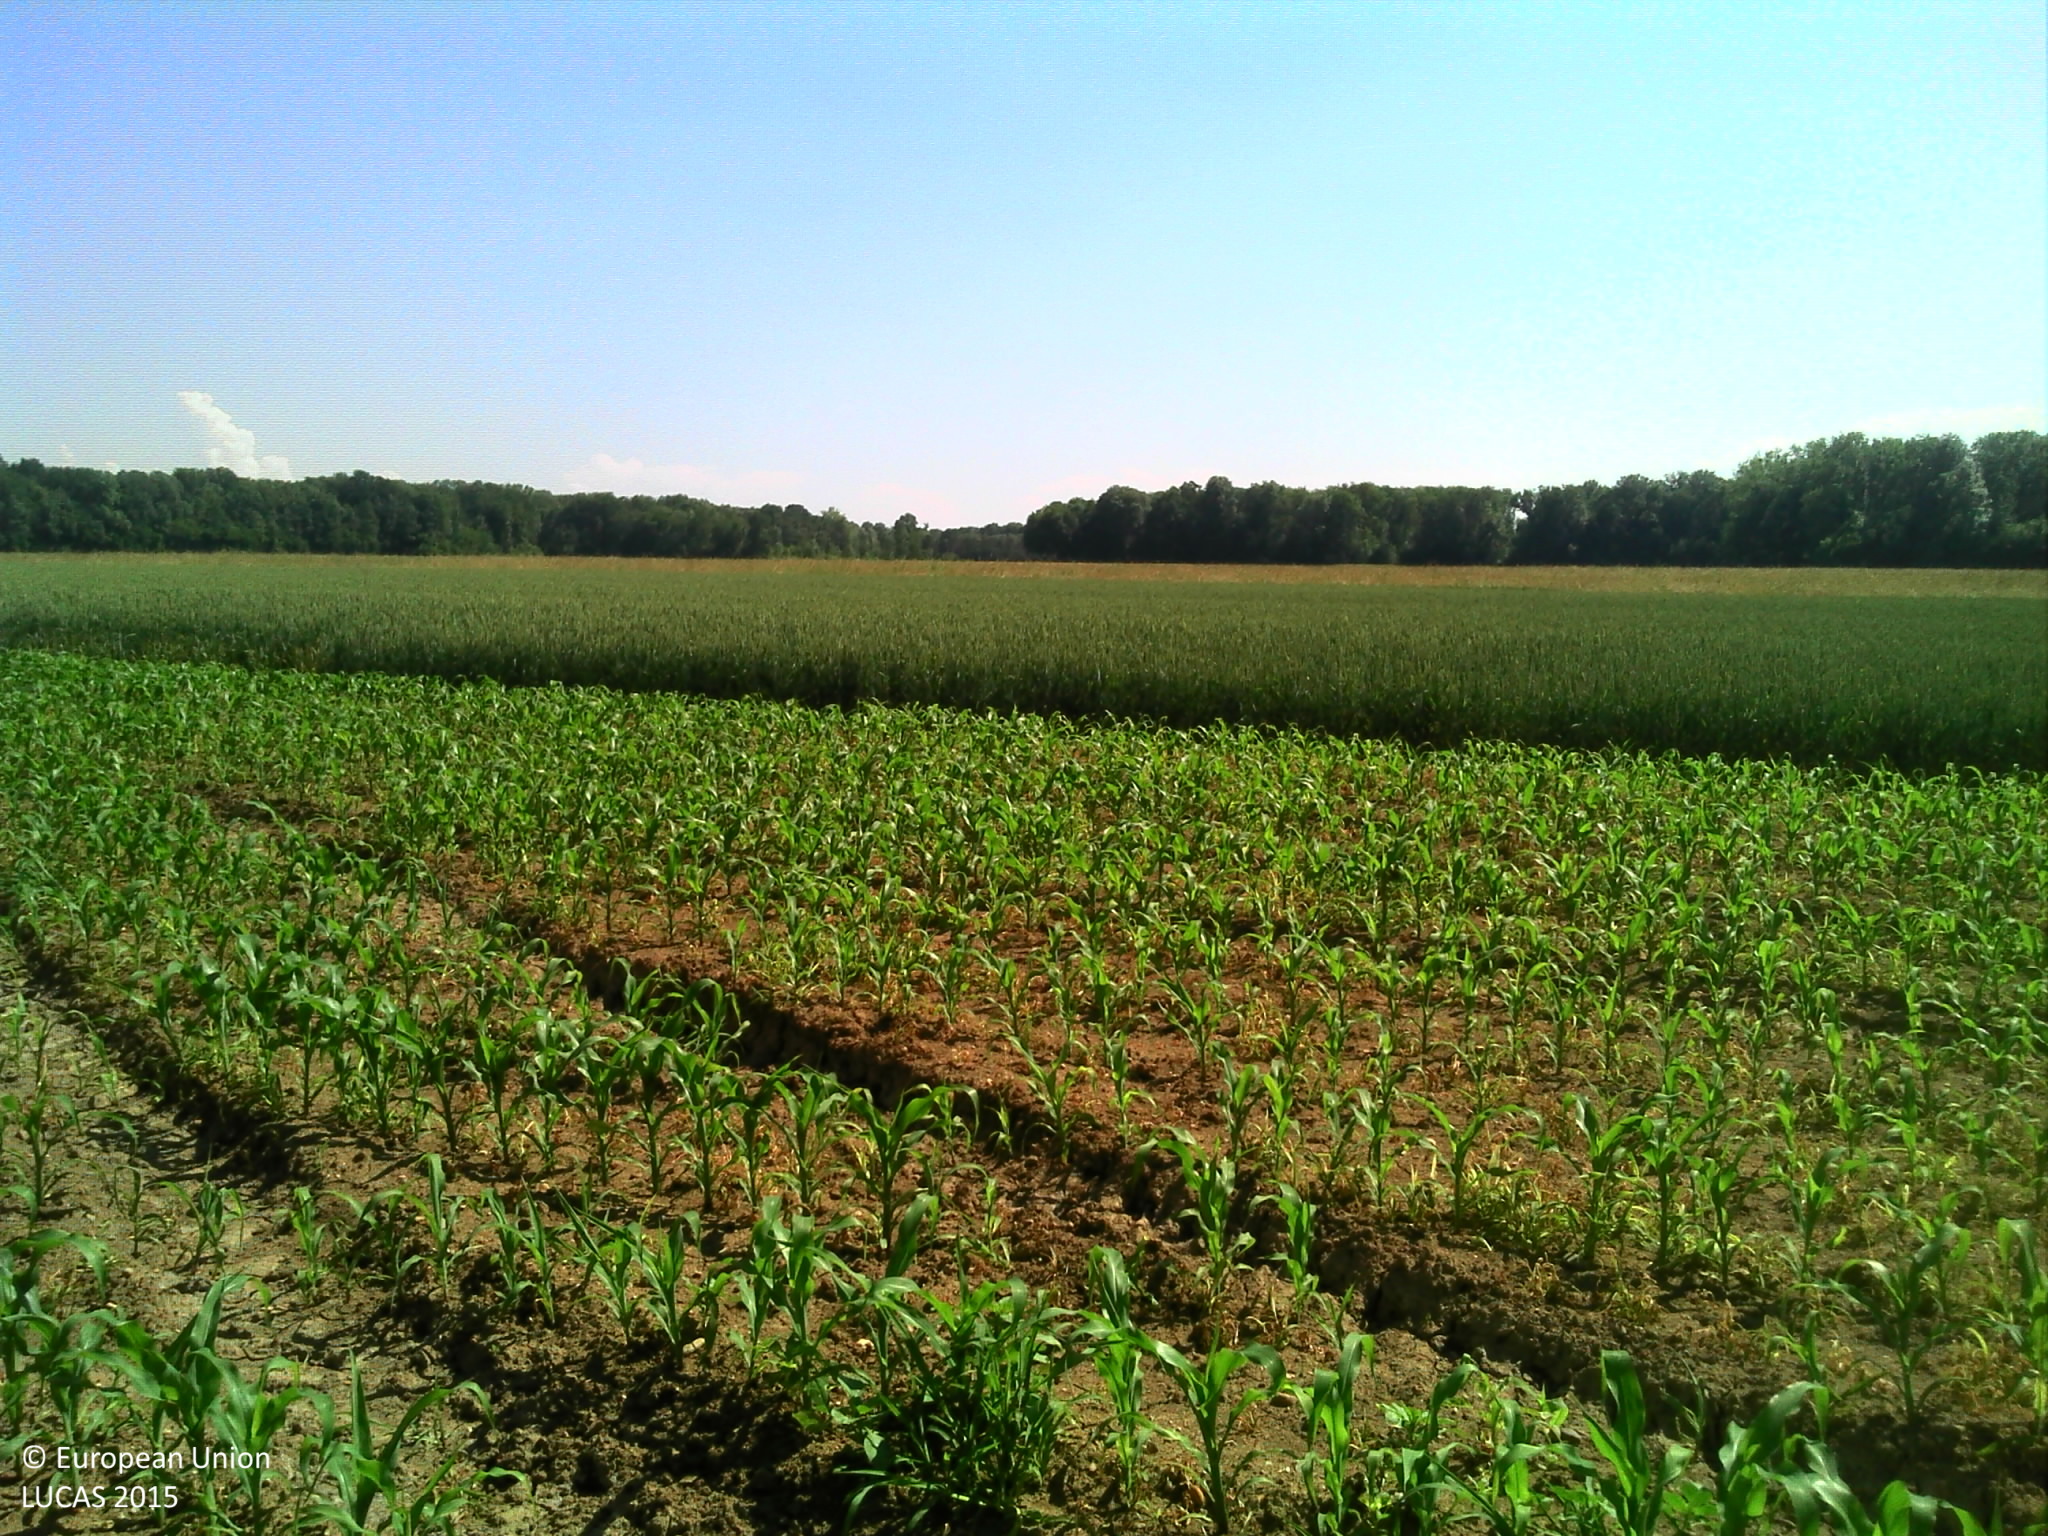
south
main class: Cropland
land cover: Maize
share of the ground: 10 - 25 %
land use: Agriculture (excluding fallow land and kitchen gardens)
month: June
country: FR
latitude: 48.4496
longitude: 7.6078
